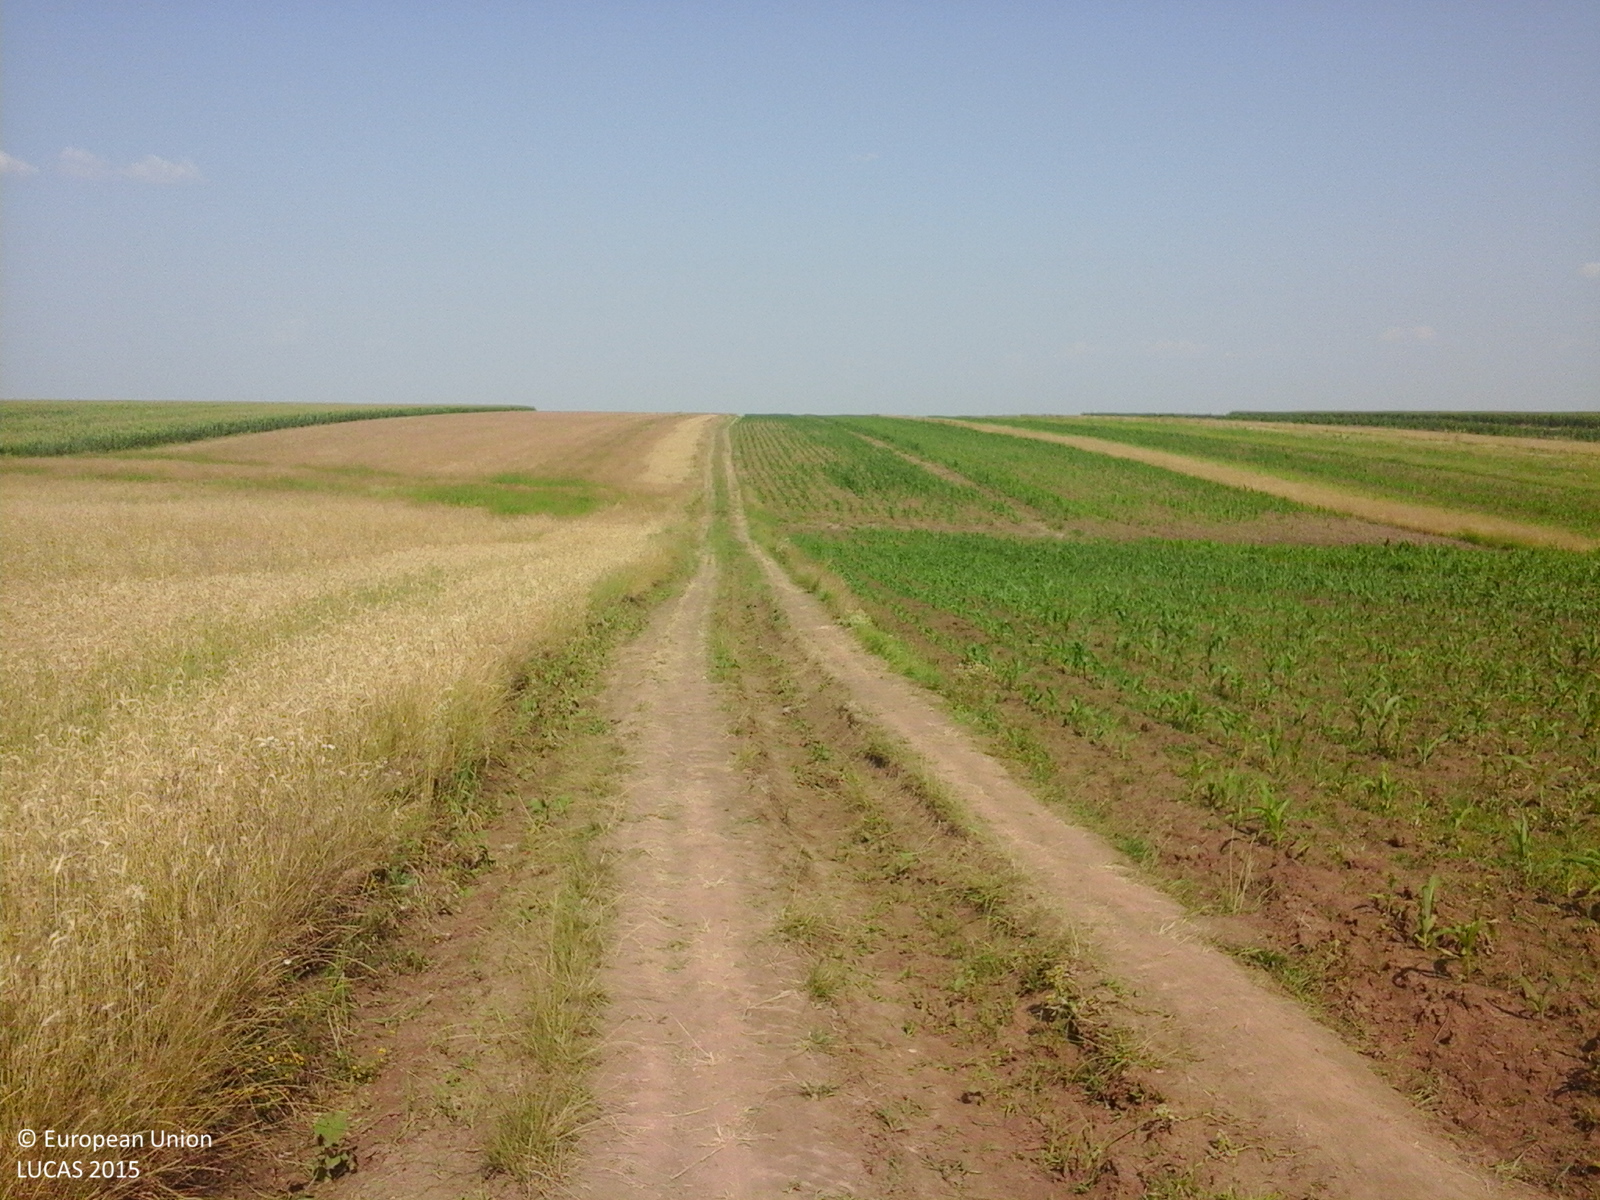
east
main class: Cropland
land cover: Maize
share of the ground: > 75 %
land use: Agriculture (excluding fallow land and kitchen gardens)
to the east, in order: Maize
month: July
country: RO
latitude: 44.6598
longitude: 24.5129
